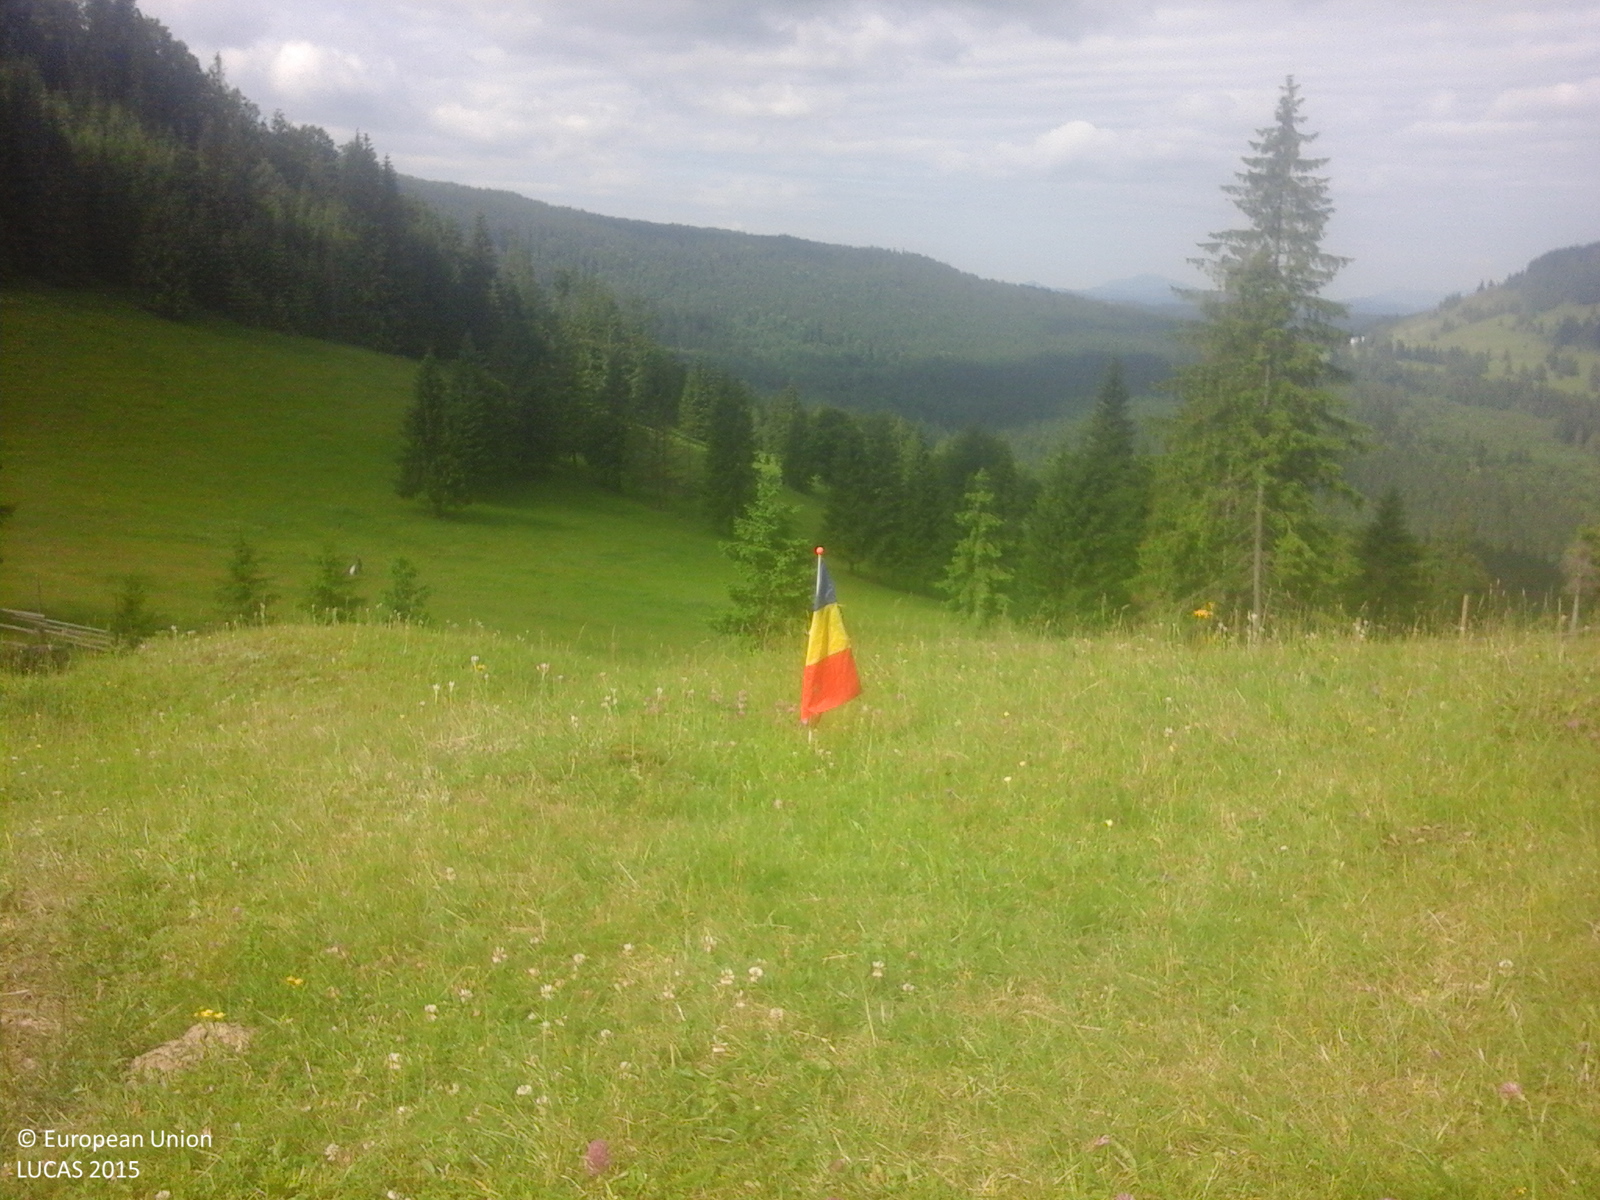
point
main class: Grassland
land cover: Grassland without tree/shrub cover
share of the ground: > 75 %
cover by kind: herbaceous plants 100 %
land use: Agriculture (excluding fallow land and kitchen gardens)
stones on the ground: < 10 %
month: June
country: RO
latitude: 47.3321
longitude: 25.2883
